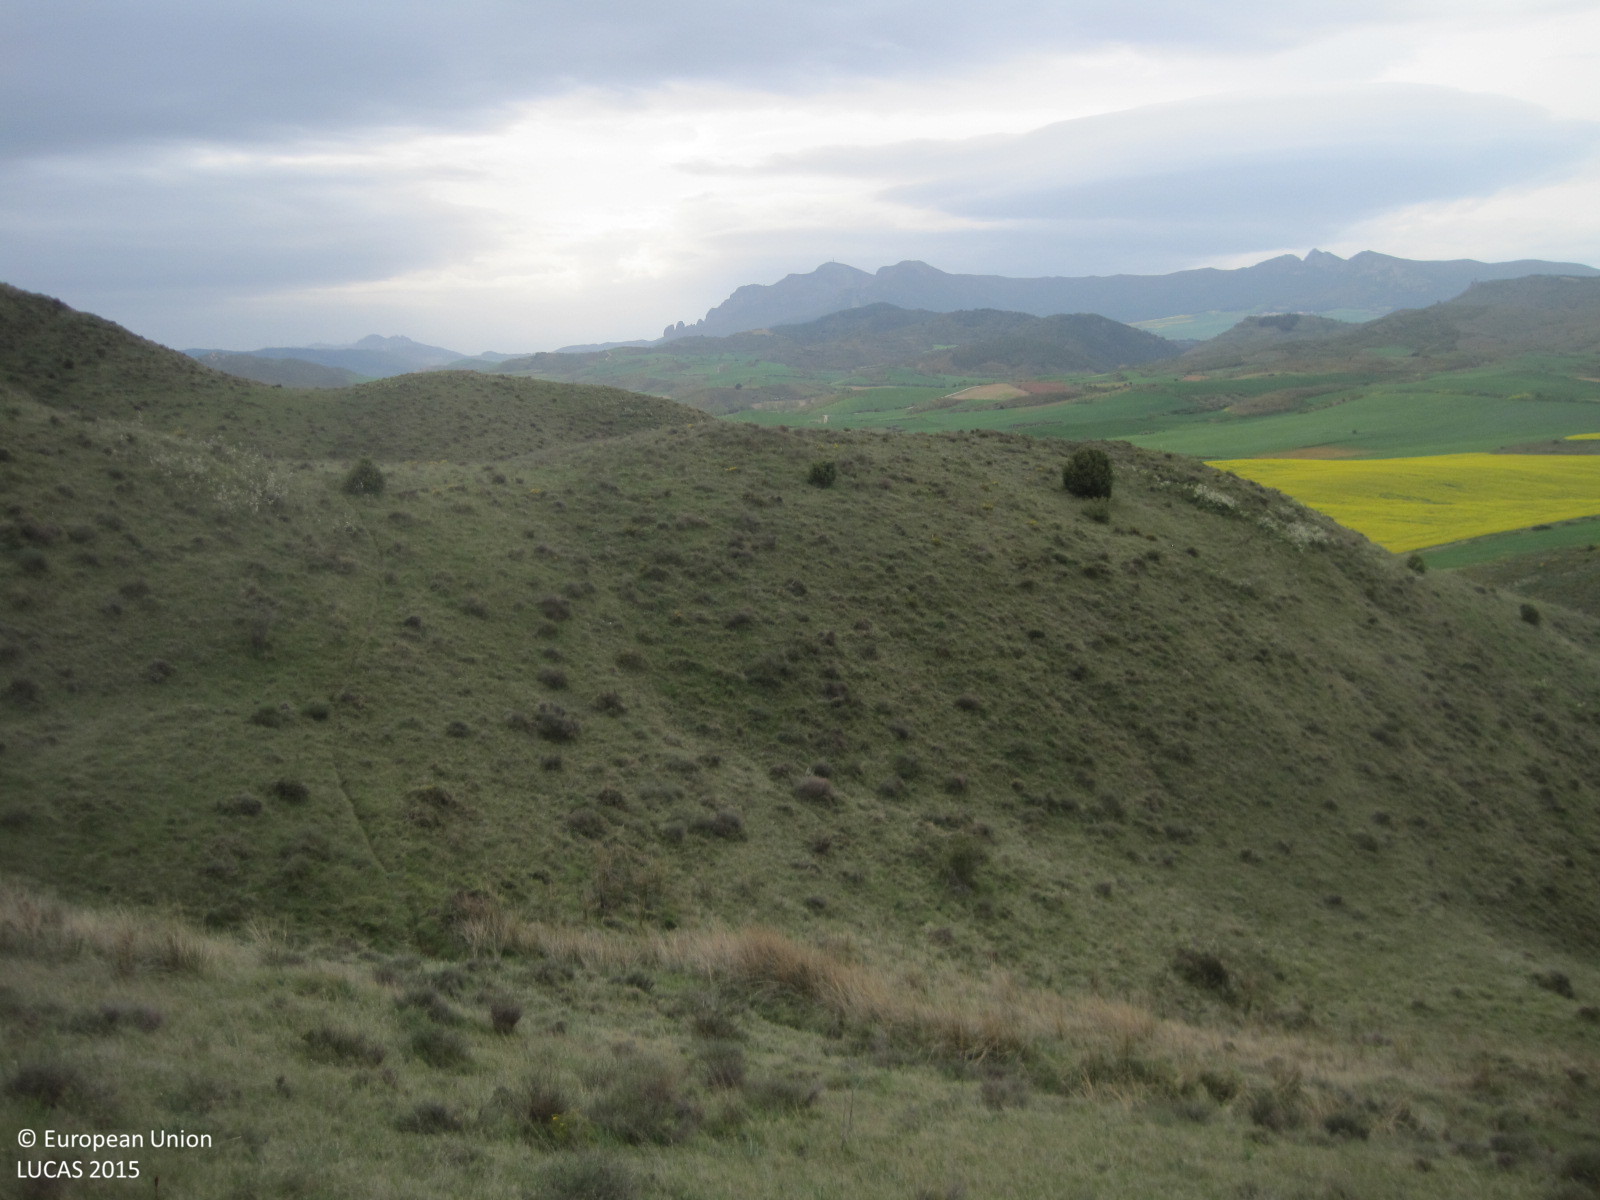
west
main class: Shrubland
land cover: Shrubland without tree cover
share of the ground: > 75 %
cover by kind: shrubs 70 %, herbaceous plants 30 %
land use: Semi-natural and natural areas not in use
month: April
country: ES
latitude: 42.5894
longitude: -2.1924
